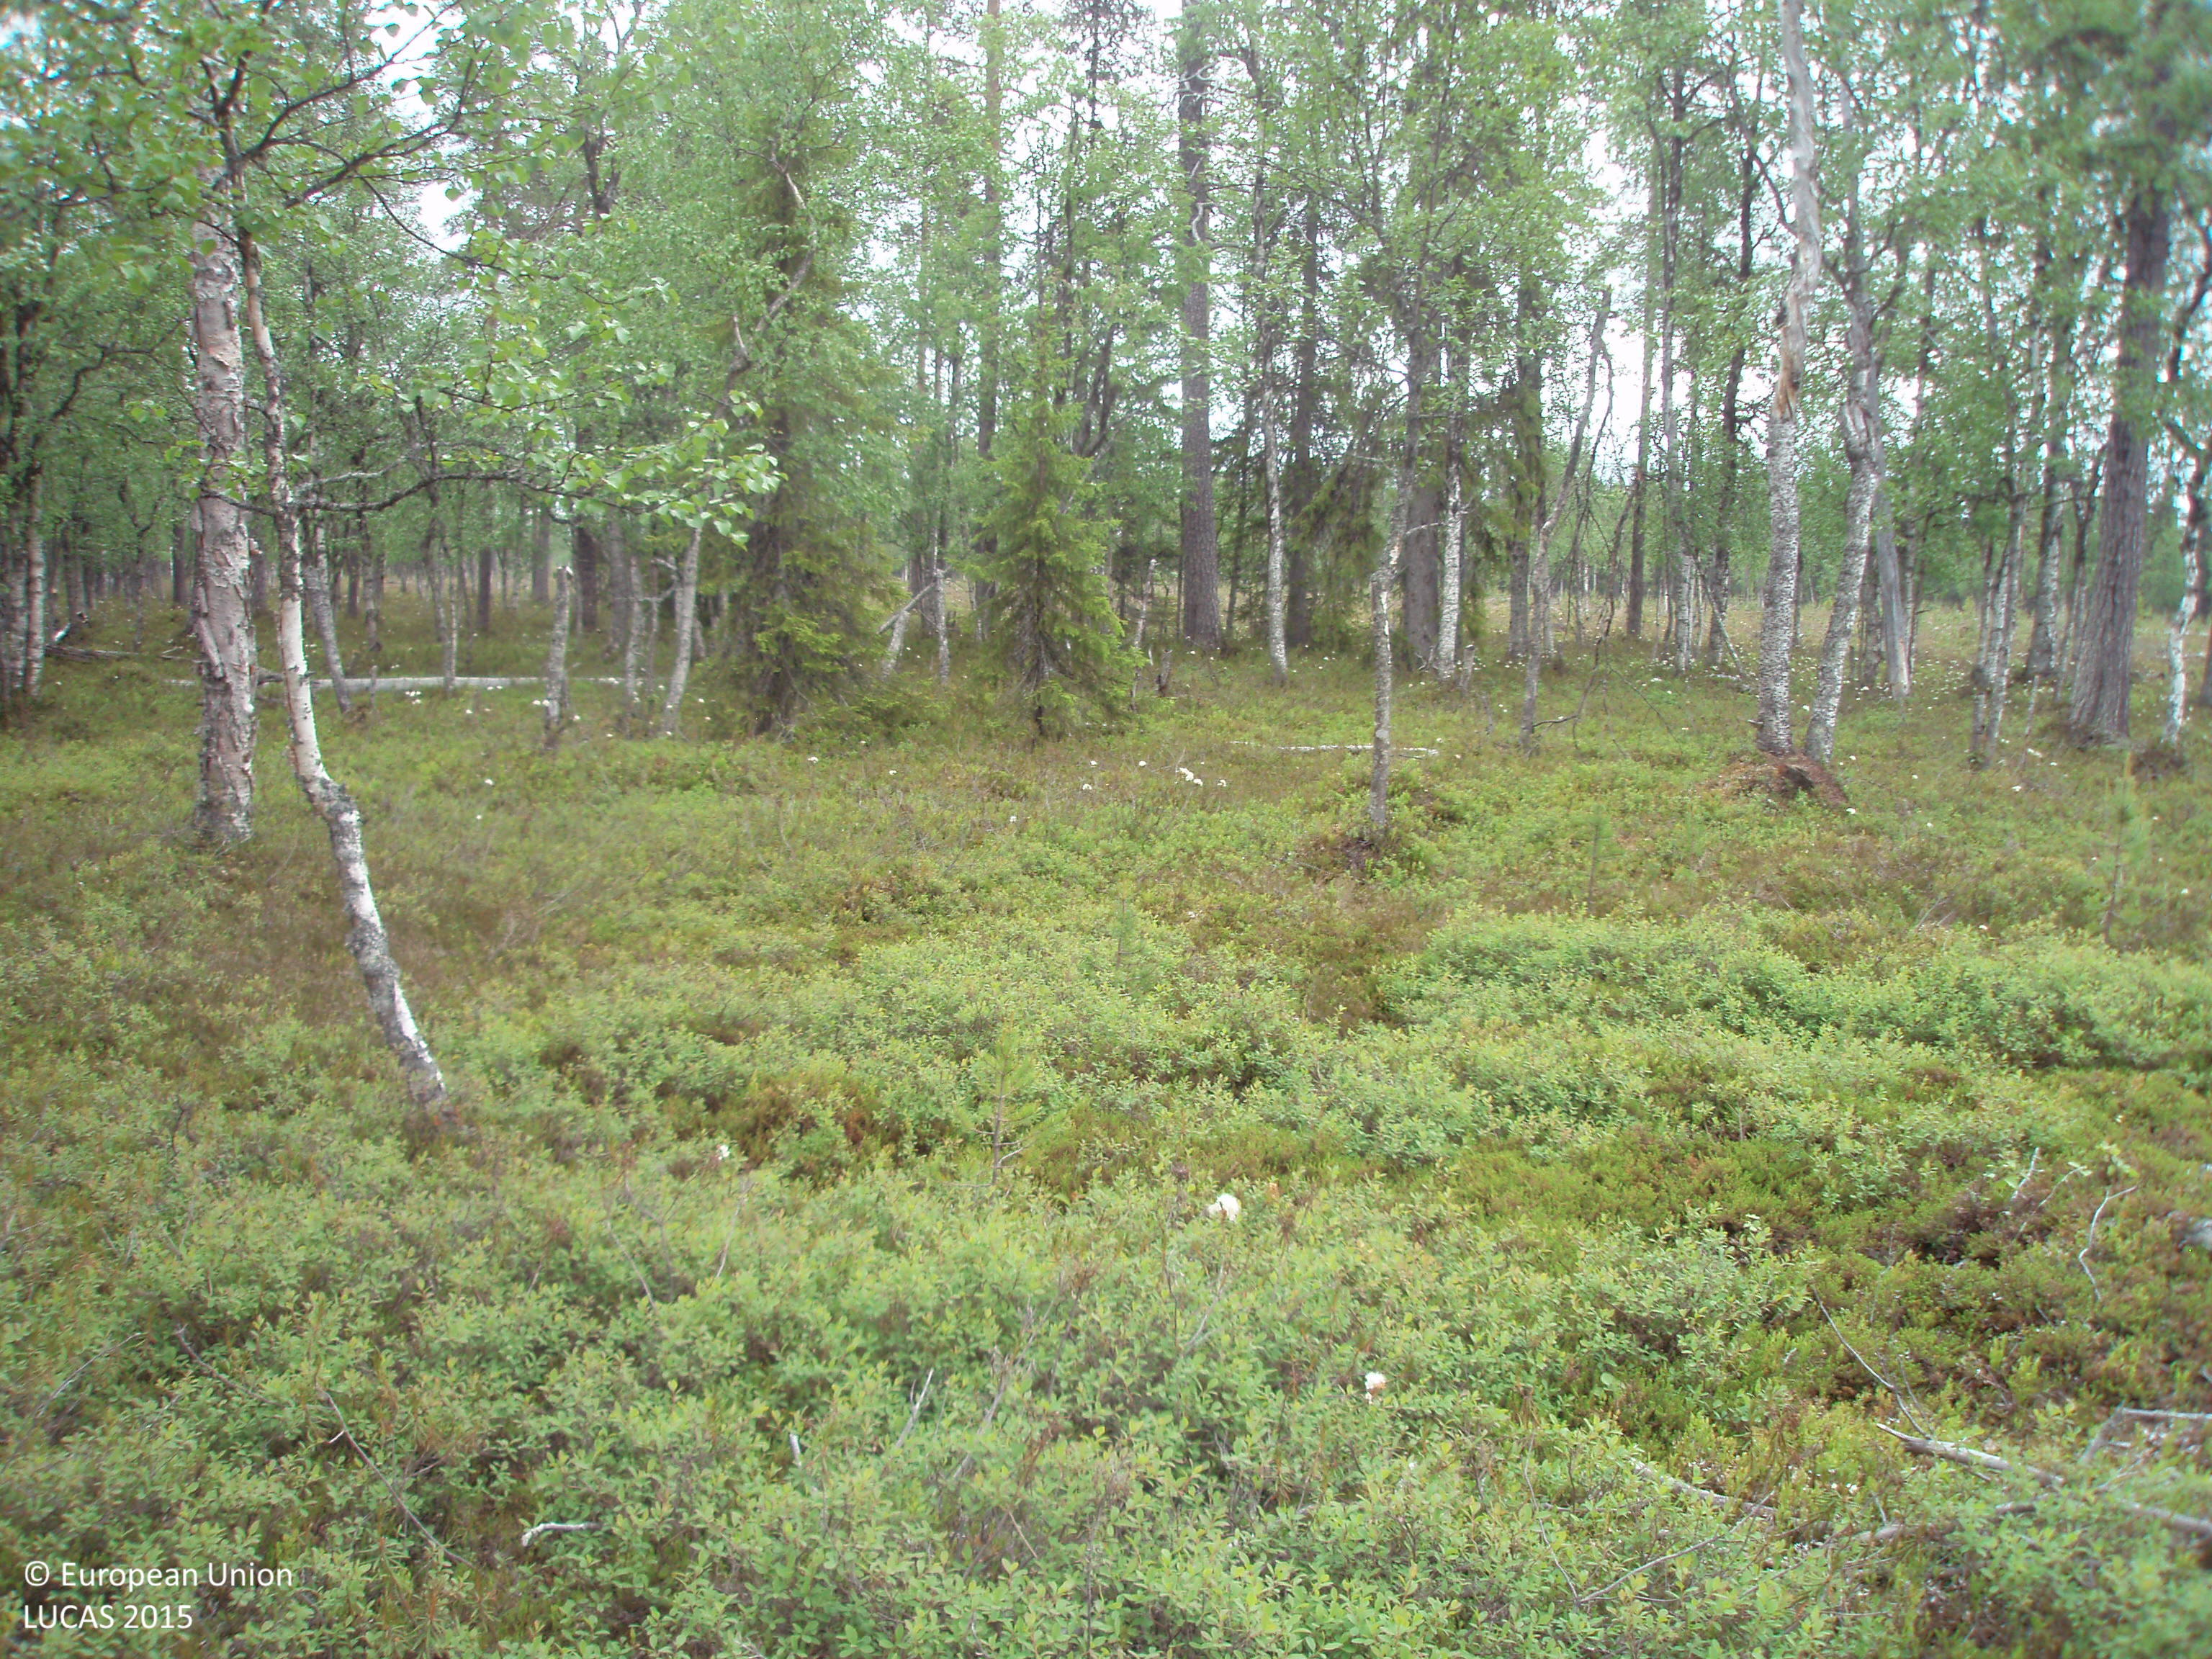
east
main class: Woodland
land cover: Pine dominated mixed woodland
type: boreal forest
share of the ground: 25 - 50 %
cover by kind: shrubs 60 %, coniferous forest trees 20 %, broadleaved forest trees 20 %
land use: Forestry
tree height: > 5 m
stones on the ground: 10 - 25 %
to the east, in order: Pine dominated mixed woodland; Shrubland with sparse tree cover; Pine dominated mixed woodland; Shrubland with sparse tree cover
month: July
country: FI
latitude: 67.6828
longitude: 28.6060
